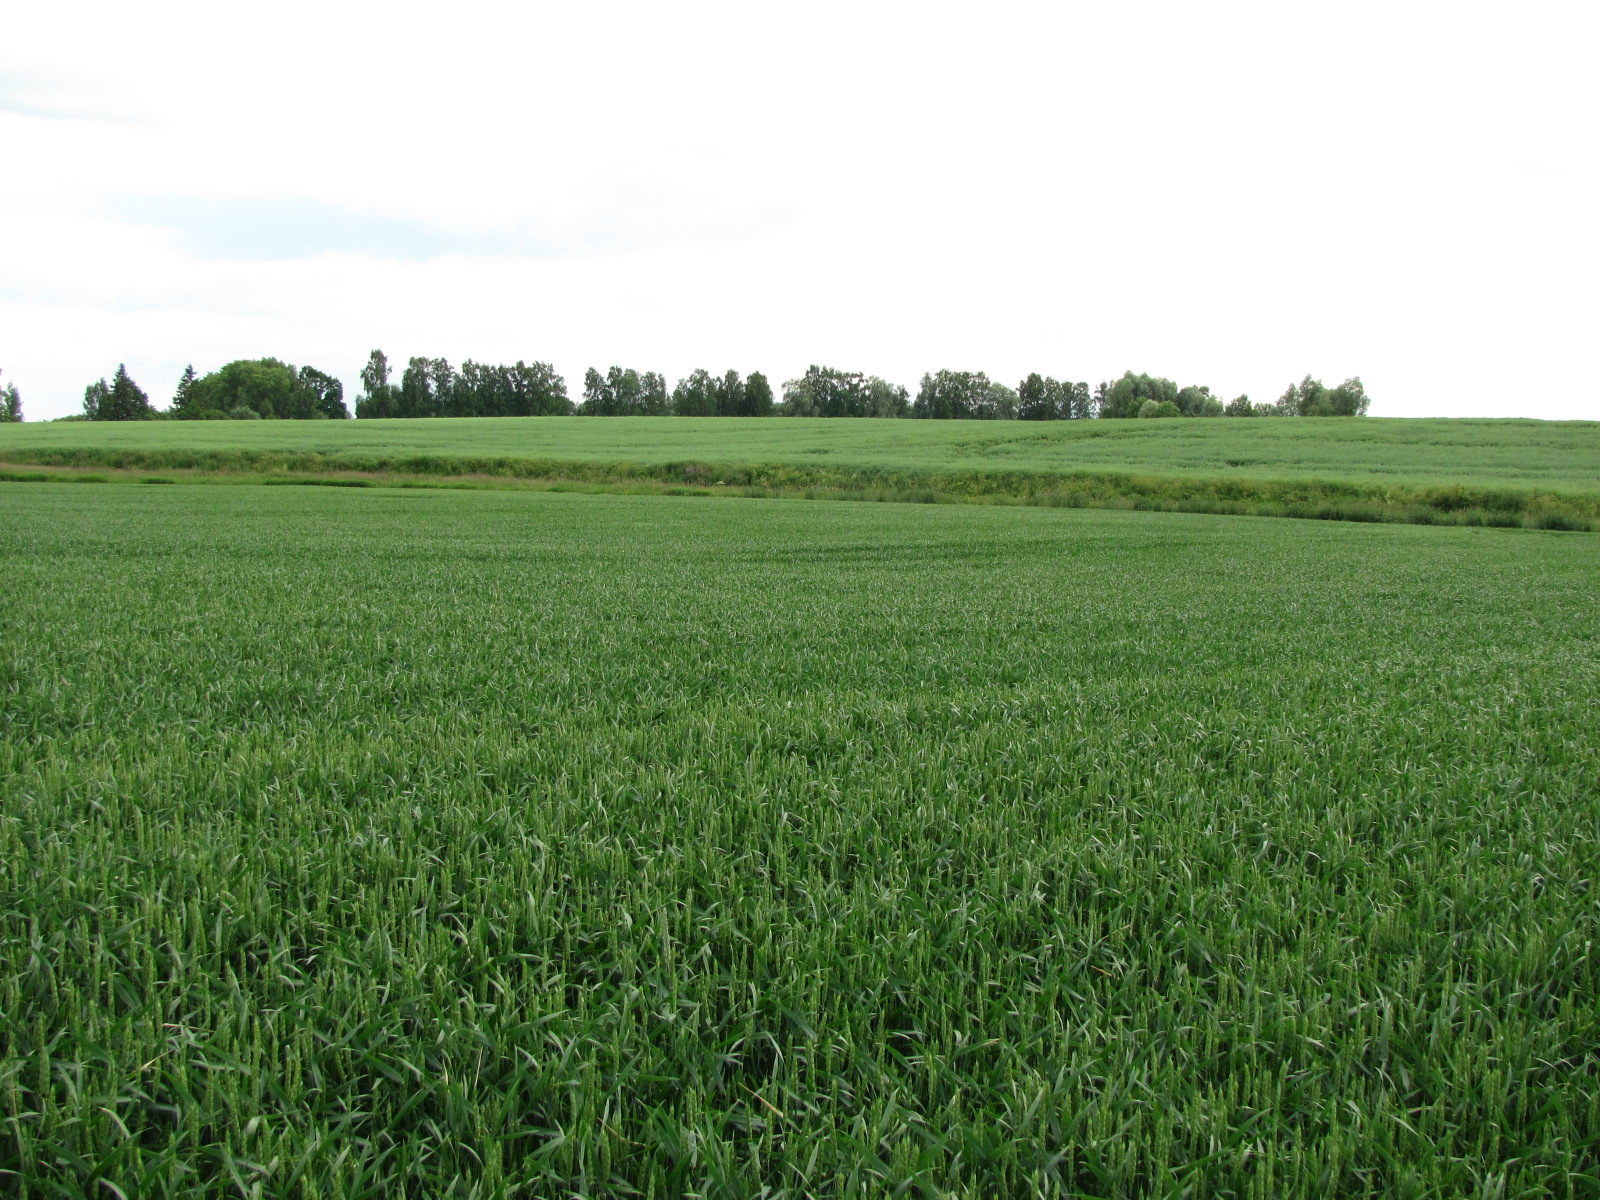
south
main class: Cropland
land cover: Common wheat
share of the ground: > 75 %
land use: Agriculture (excluding fallow land and kitchen gardens)
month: June
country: LV
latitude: 56.4756
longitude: 23.9985
